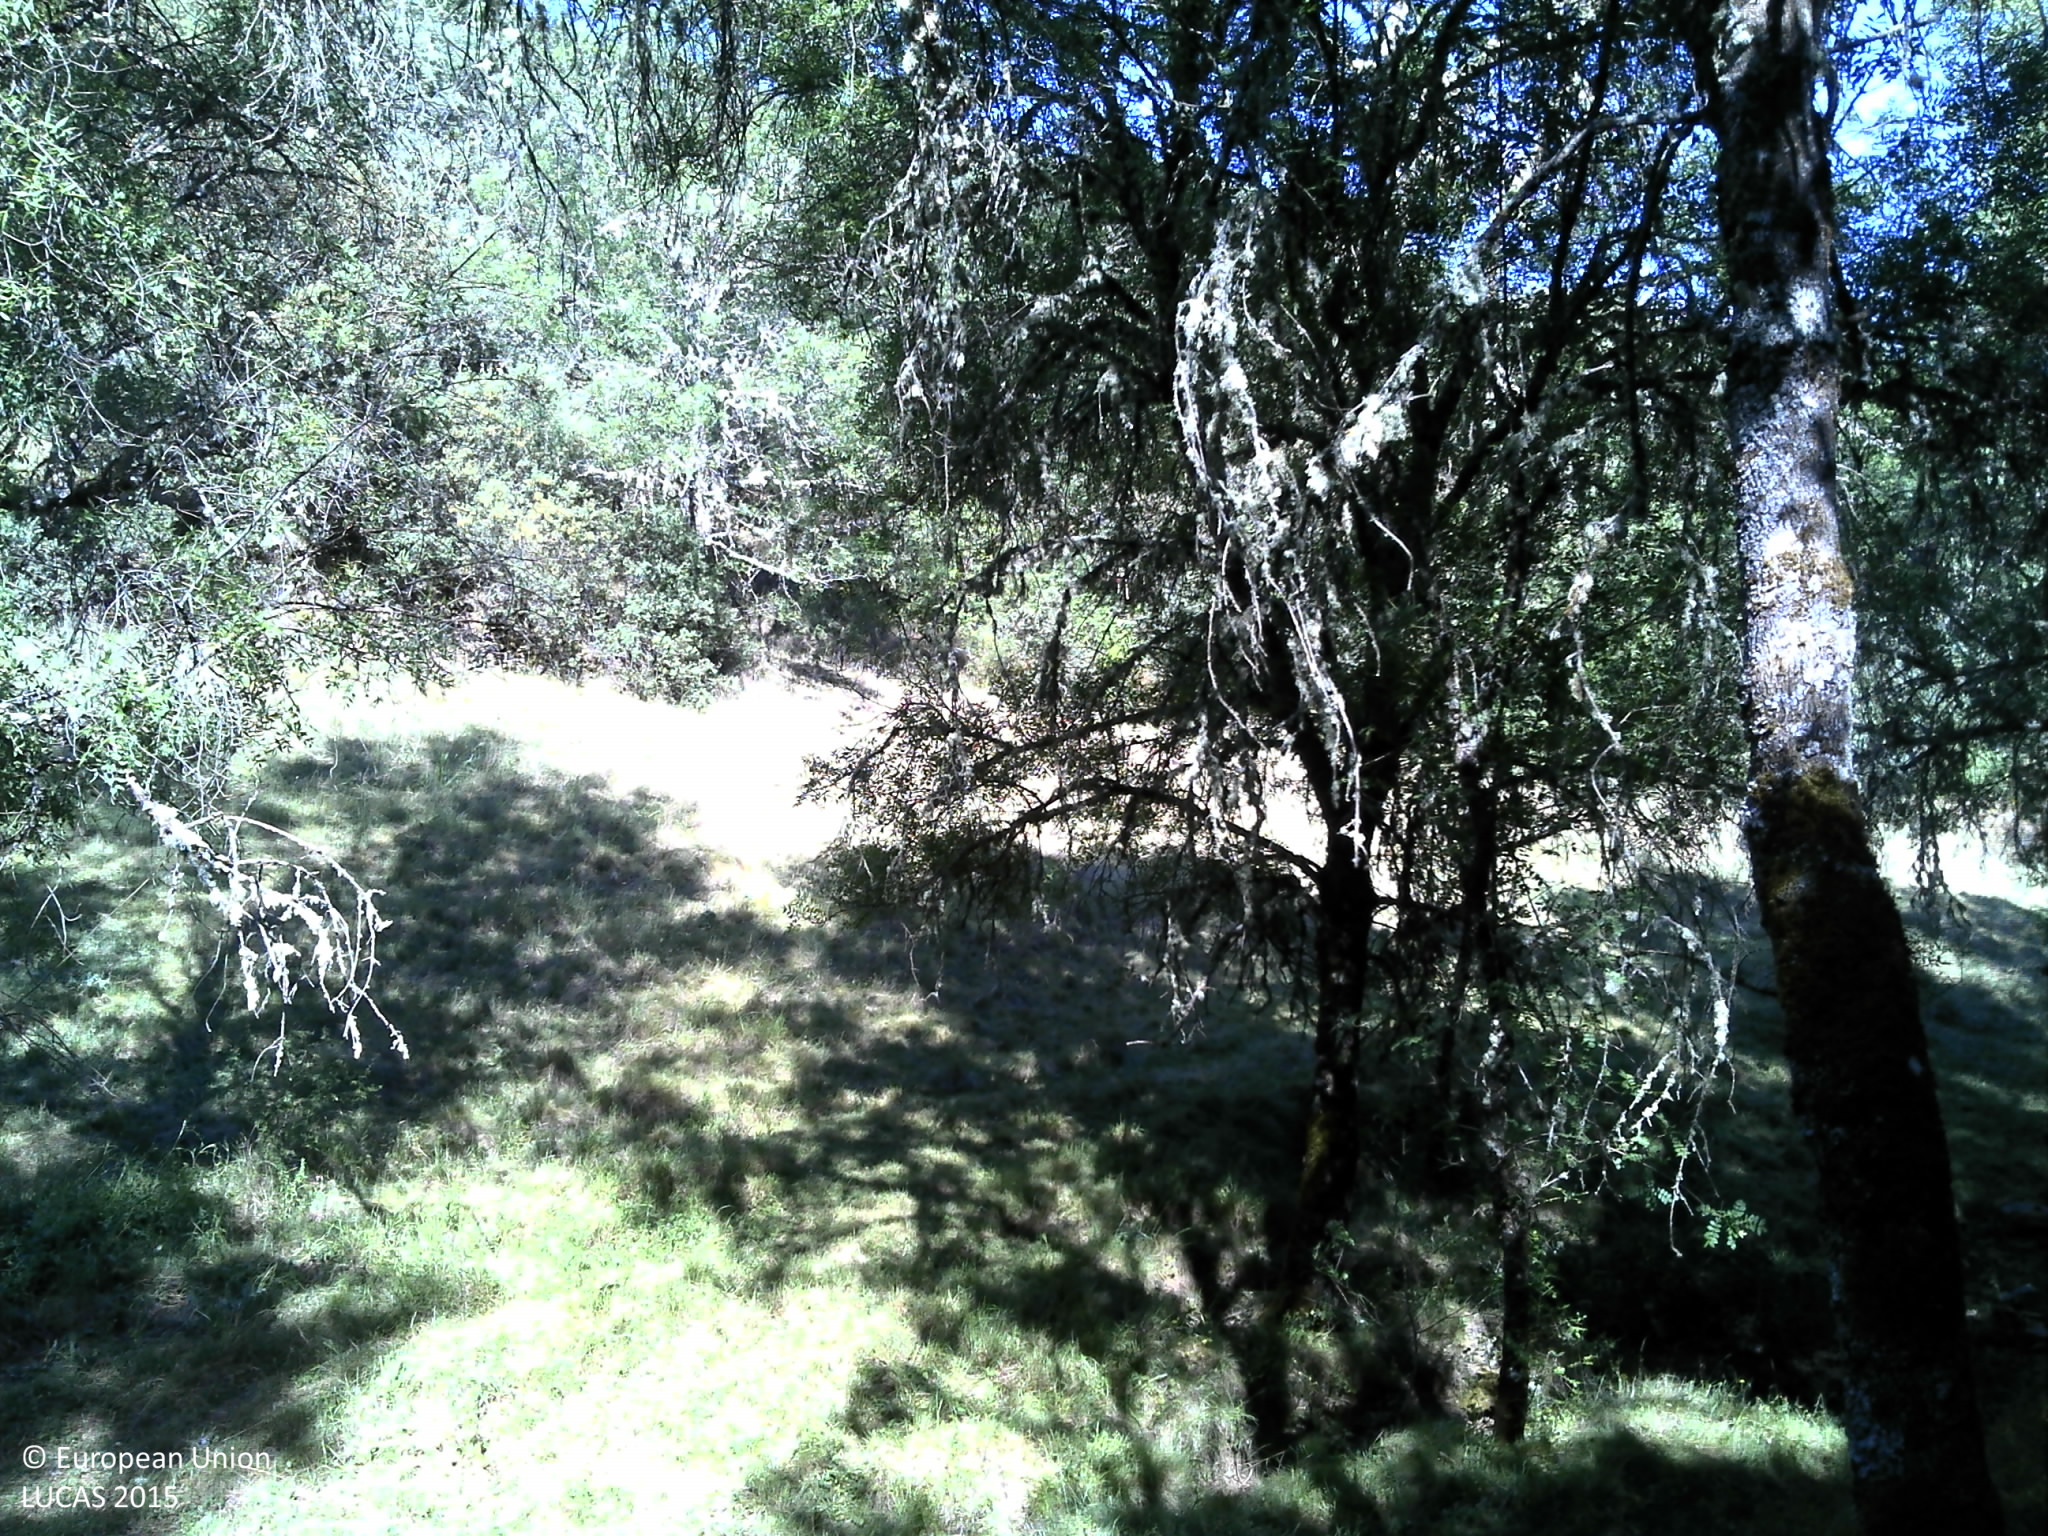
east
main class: Woodland
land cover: Broadleaved woodland
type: thermophilous deciduous forest
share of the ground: > 75 %
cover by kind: shrubs 50 %, broadleaved forest trees 25 %, herbaceous plants 20 %, coniferous forest trees 5 %
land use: Forestry
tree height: > 5 m
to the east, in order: Broadleaved woodland; Dry stone walls; Grassland with sparse tree/shrub cover; Shrubland with sparse tree cover; Tracks; Shrubland with sparse tree cover; Olive groves; Abandoned hedges; Dry stone walls; Olive groves; Other bare soil
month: May
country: PT
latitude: 41.7520
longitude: -6.5965
